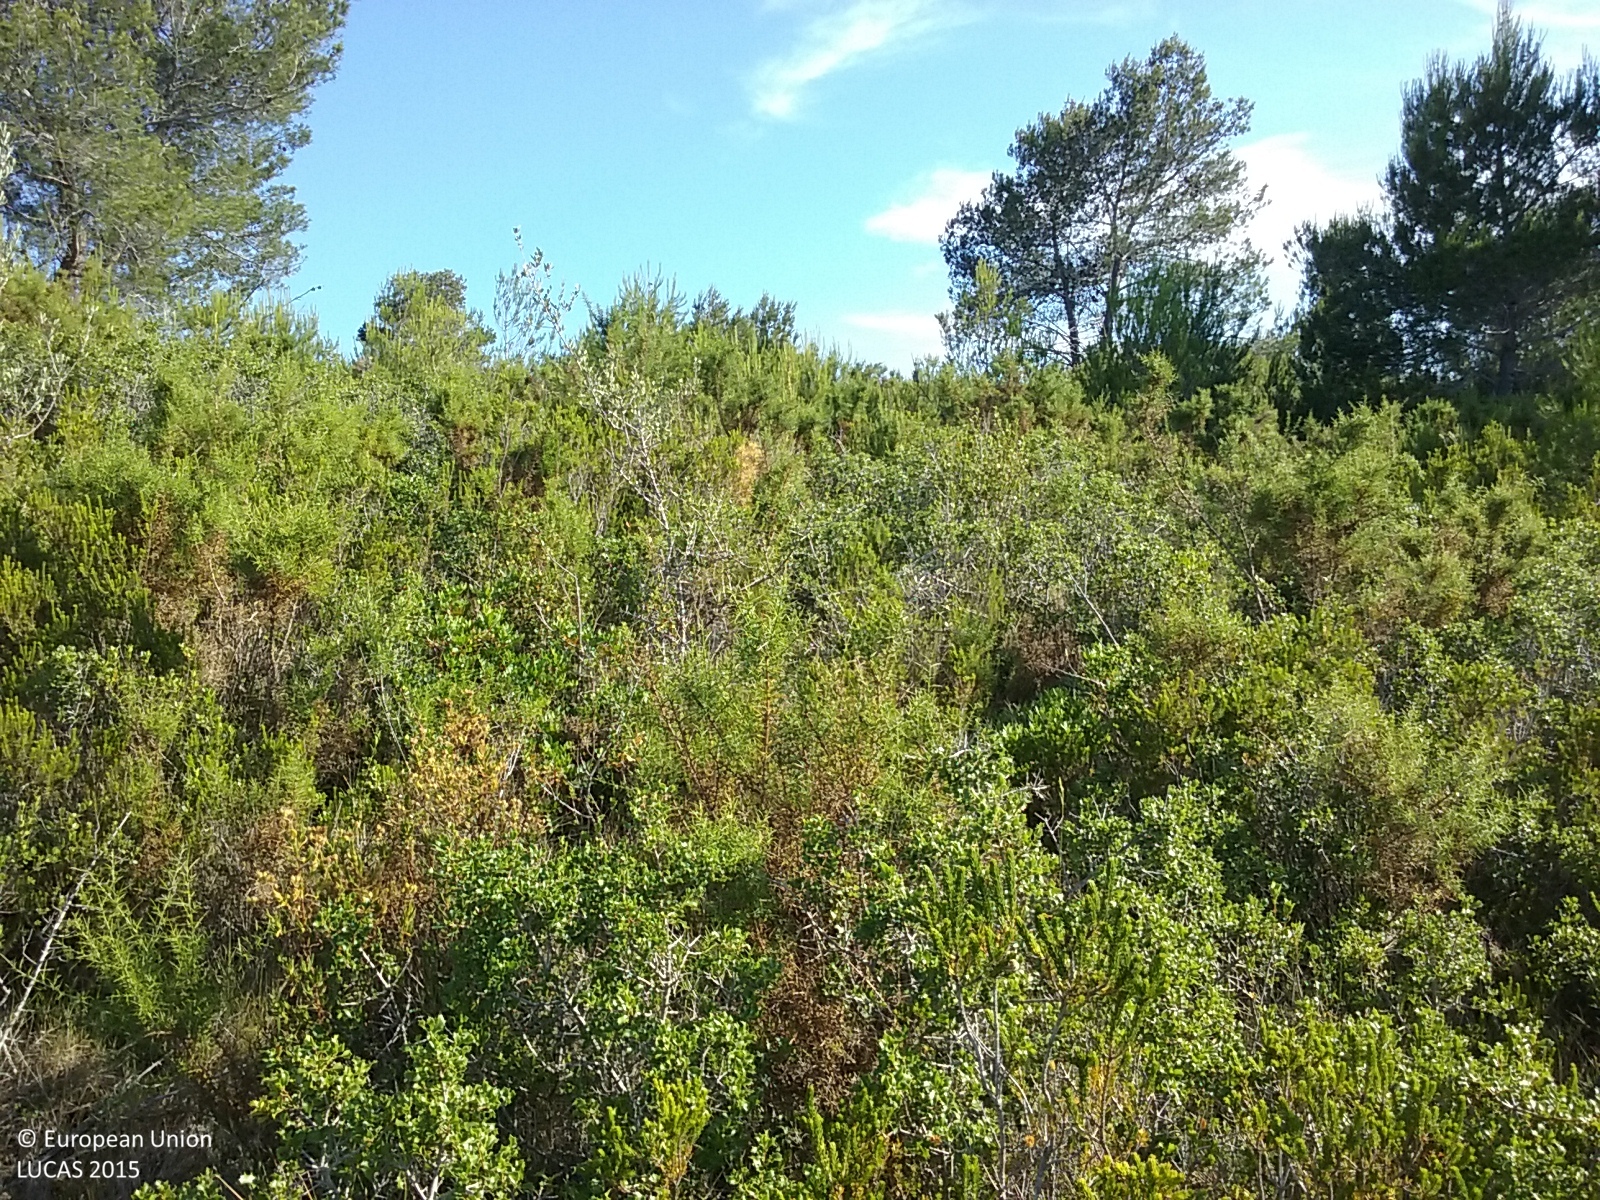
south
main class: Shrubland
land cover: Shrubland with sparse tree cover
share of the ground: > 75 %
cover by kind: shrubs 90 %, coniferous forest trees 5 %, herbaceous plants 5 %
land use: Semi-natural and natural areas not in use
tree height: < 5 m
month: June
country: ES
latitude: 40.1864
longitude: 0.1200
